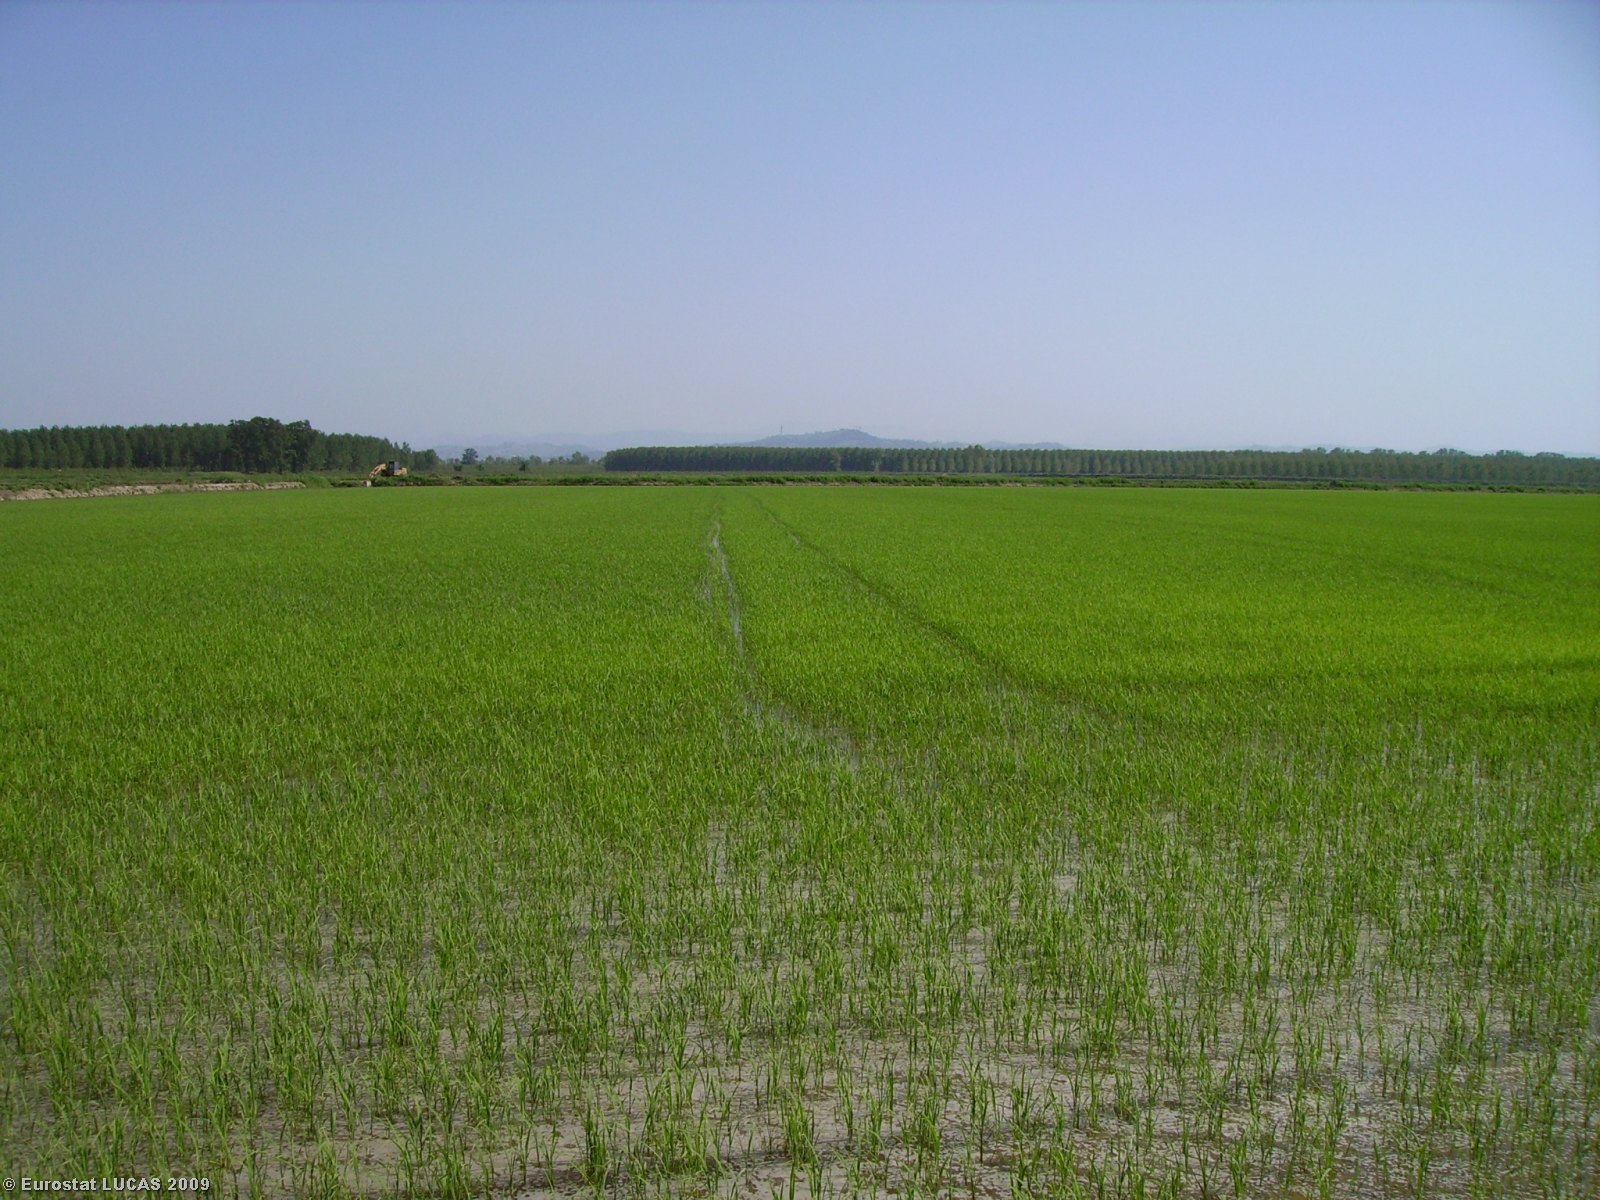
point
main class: Cropland
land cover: Rice
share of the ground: 10 - 25 %
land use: Agriculture (excluding fallow land and kitchen gardens)
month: May
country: IT
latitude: 45.1414
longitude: 9.2765
